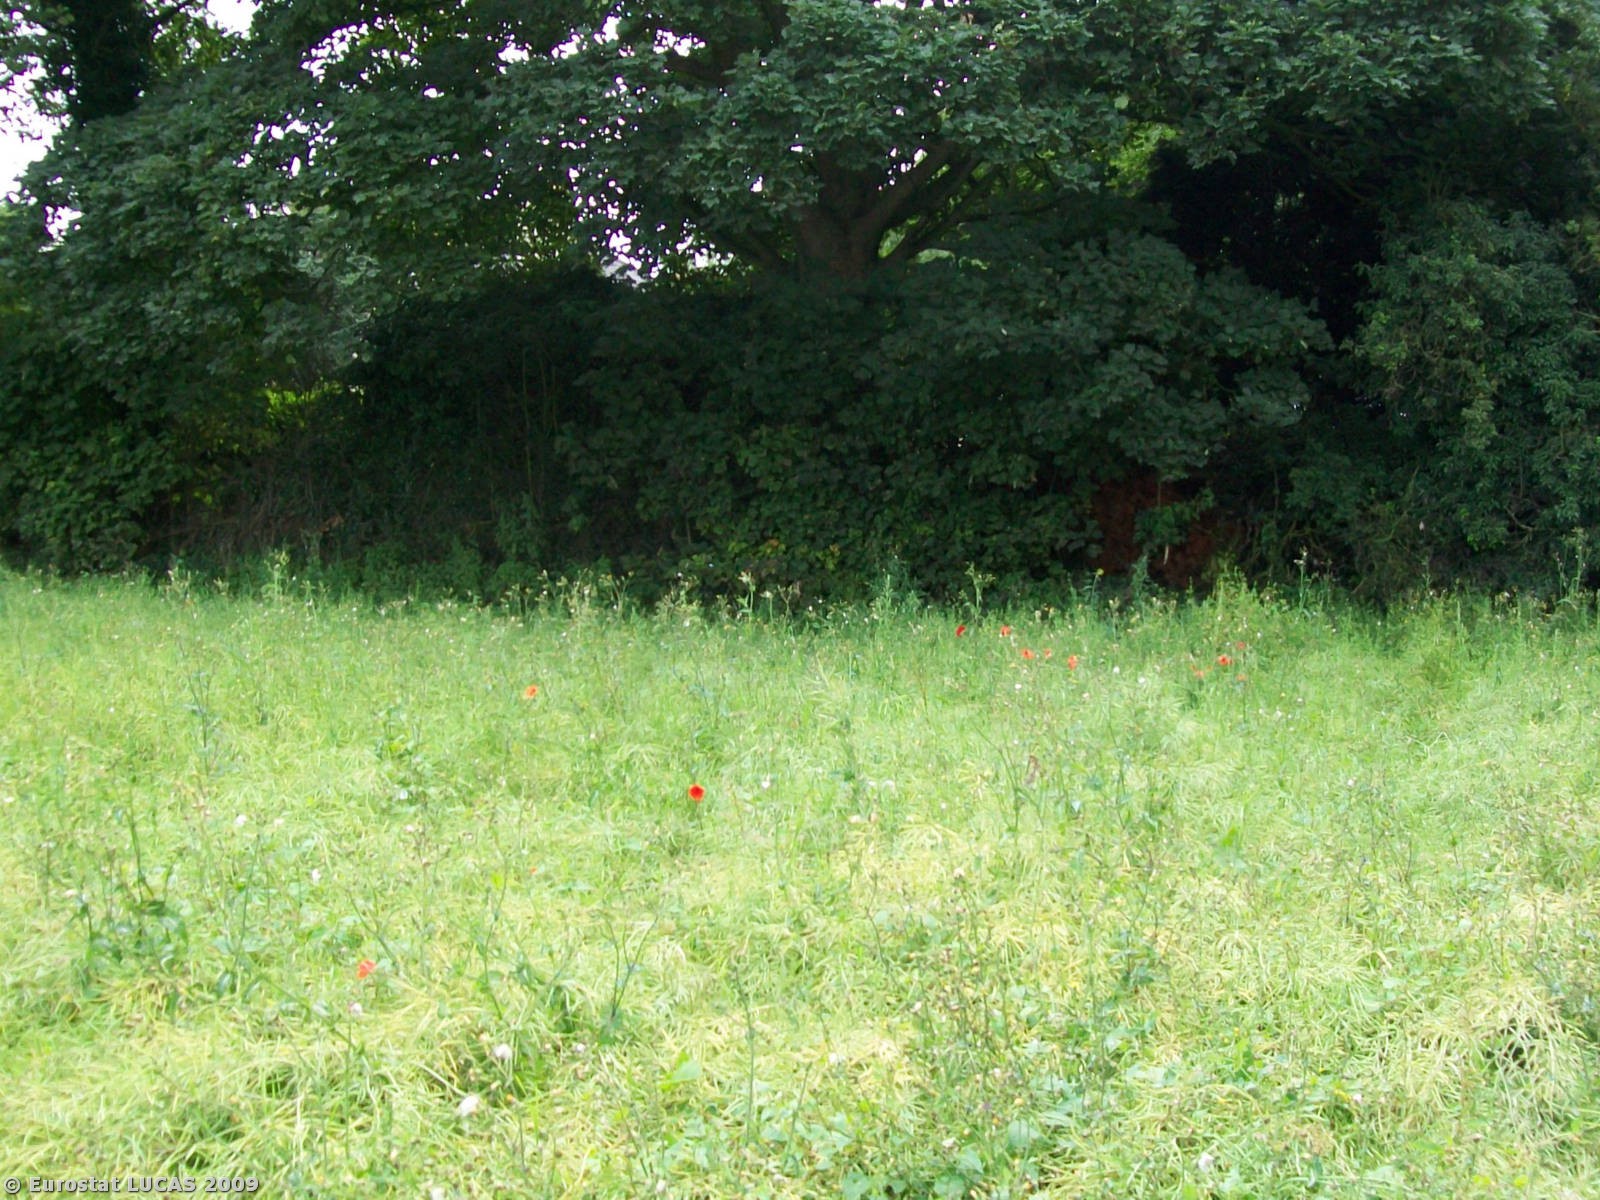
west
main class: Cropland
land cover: Rape and turnip rape
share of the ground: > 75 %
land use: Agriculture (excluding fallow land and kitchen gardens)
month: July
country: GB
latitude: 53.2577
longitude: -1.2444
